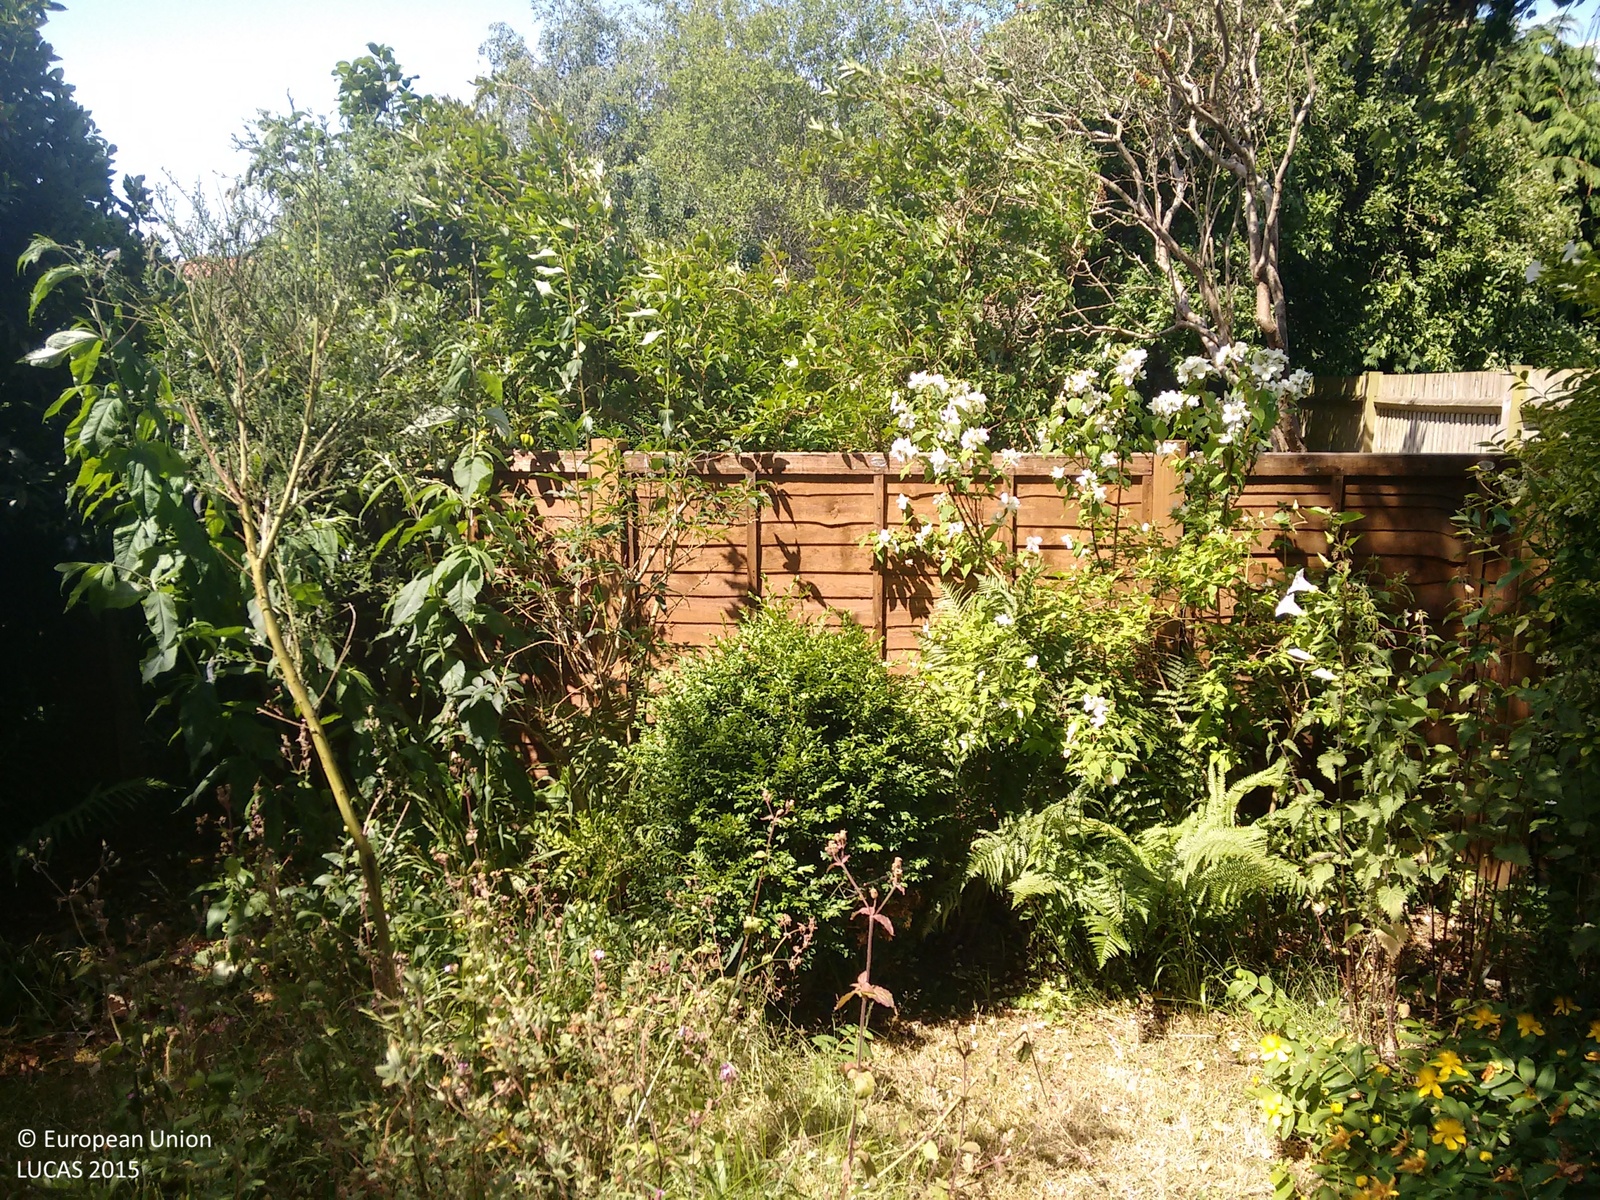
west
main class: Woodland
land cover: Broadleaved woodland
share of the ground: > 75 %
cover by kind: broadleaved forest trees 100 %
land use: Residential
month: July
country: GB
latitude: 51.1750
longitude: -0.6101
